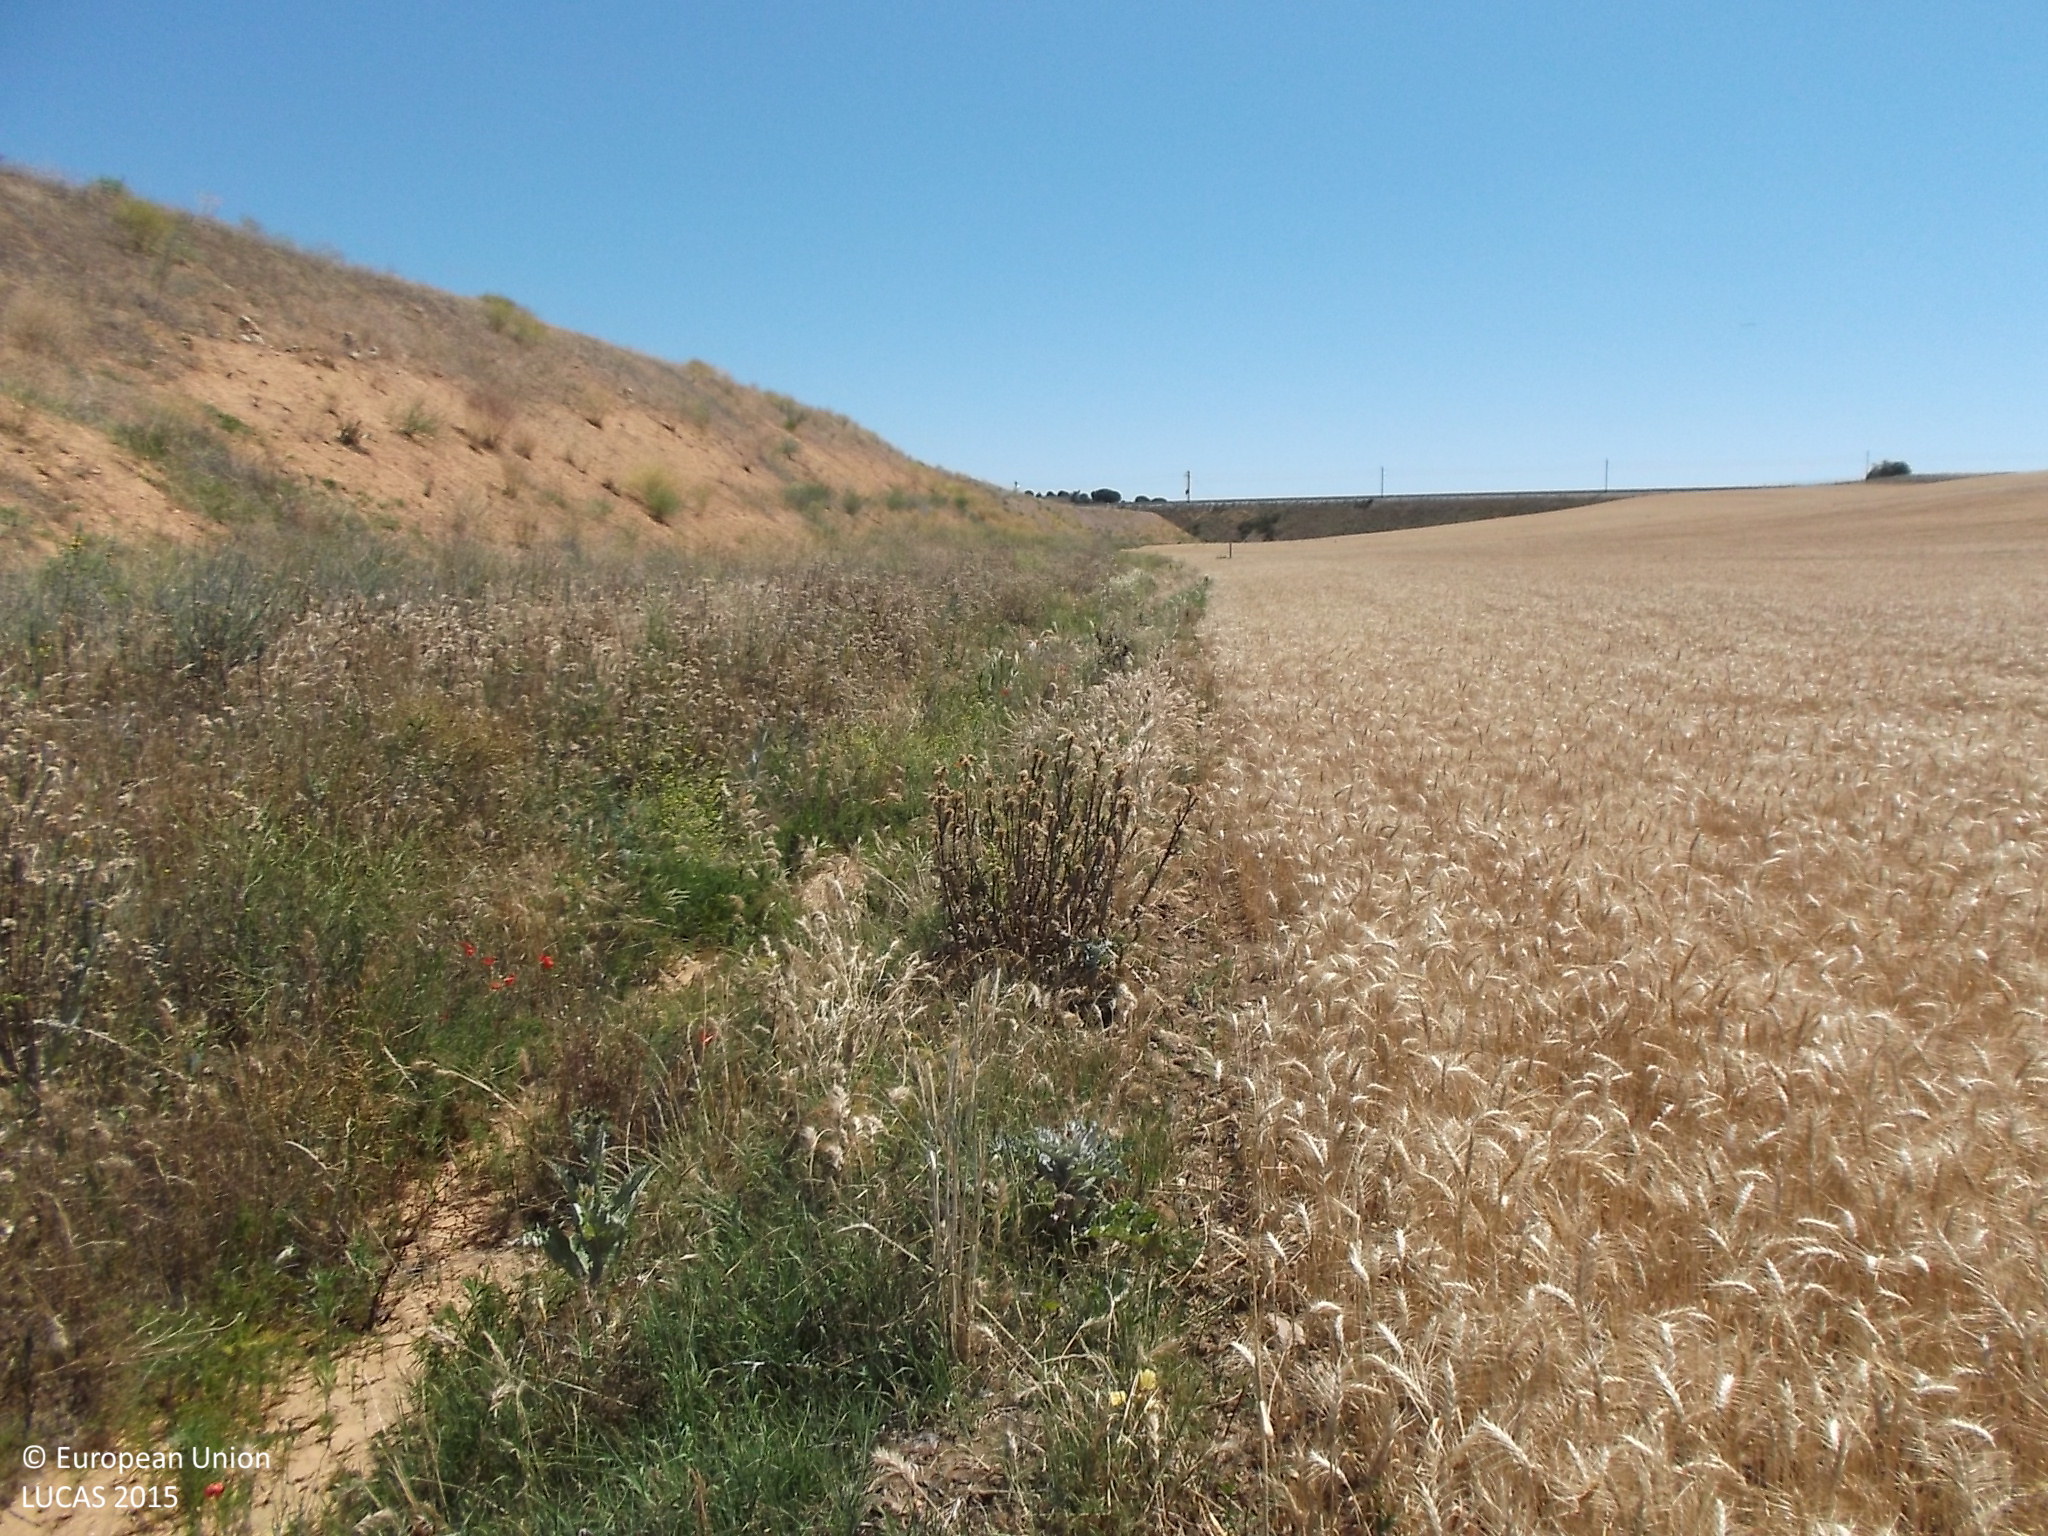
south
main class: Cropland
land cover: Common wheat
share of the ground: > 75 %
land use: Agriculture (excluding fallow land and kitchen gardens)
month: June
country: ES
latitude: 41.4411
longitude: -5.3376
